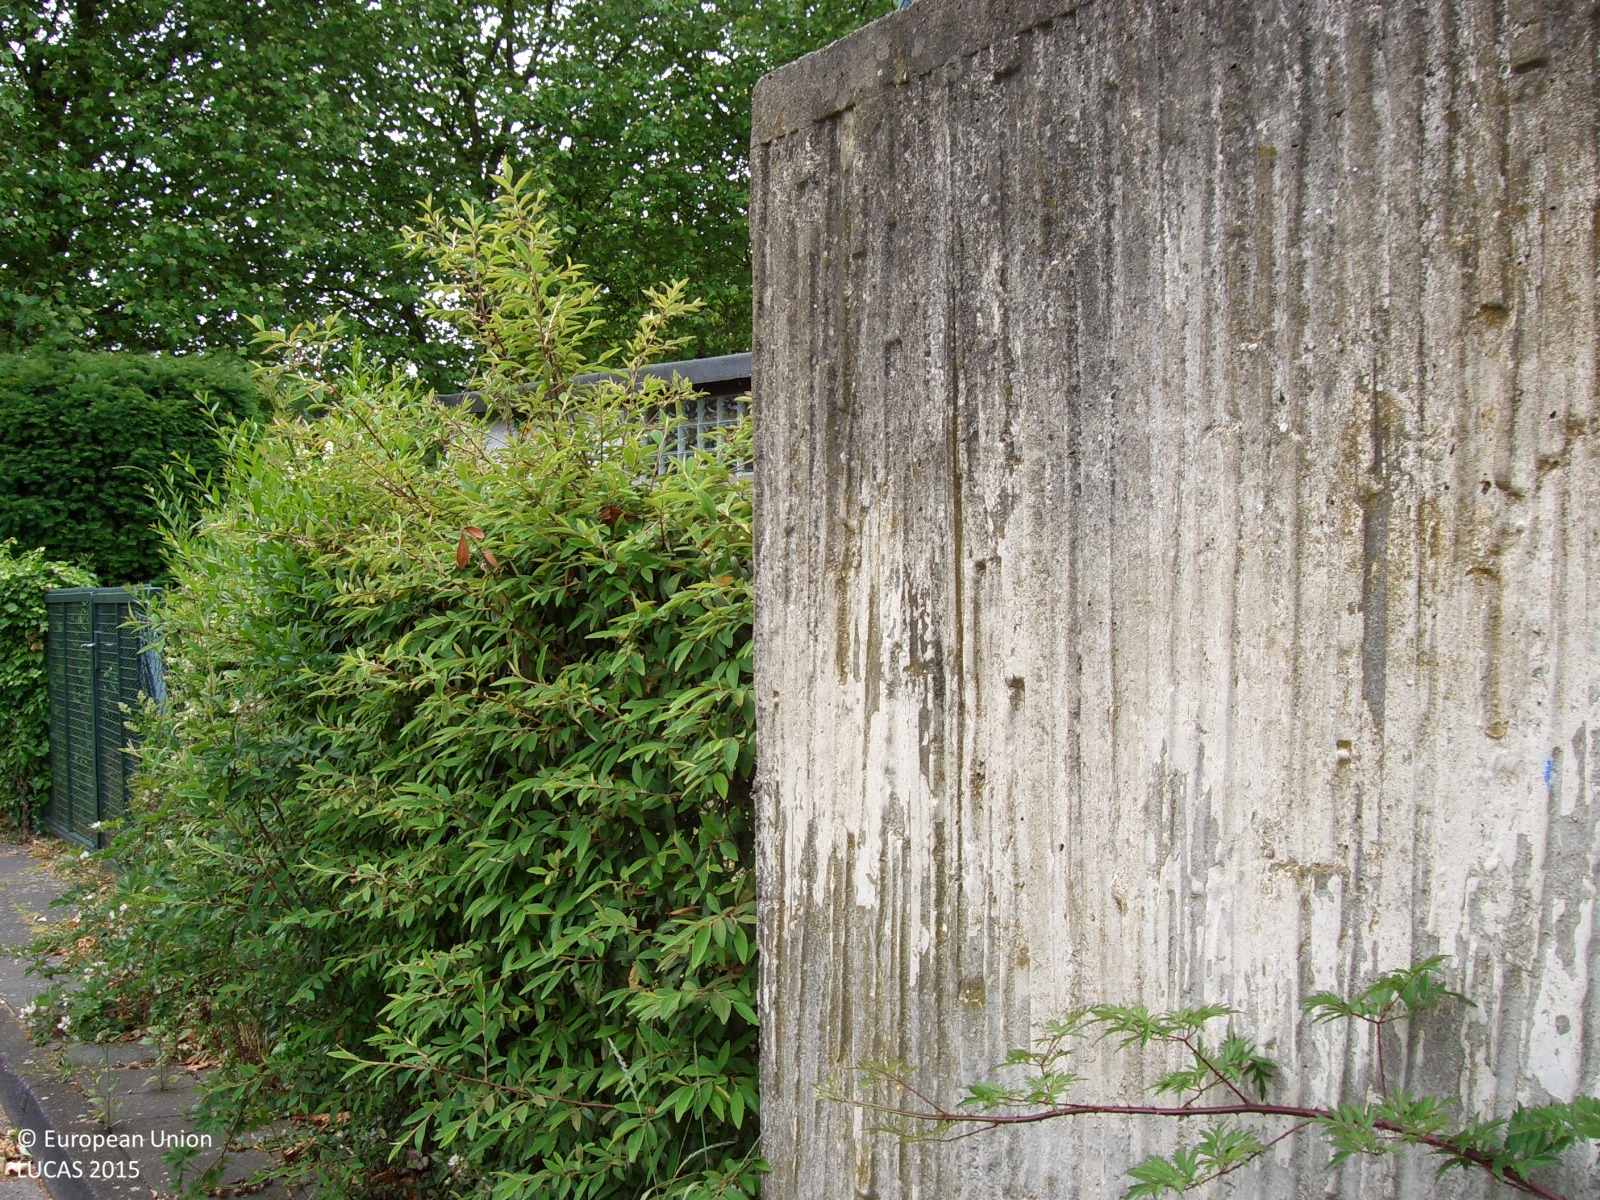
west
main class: Woodland
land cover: Broadleaved woodland
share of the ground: > 75 %
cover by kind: broadleaved forest trees 100 %
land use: Residential
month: June
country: DE
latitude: 51.1549
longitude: 7.0976
